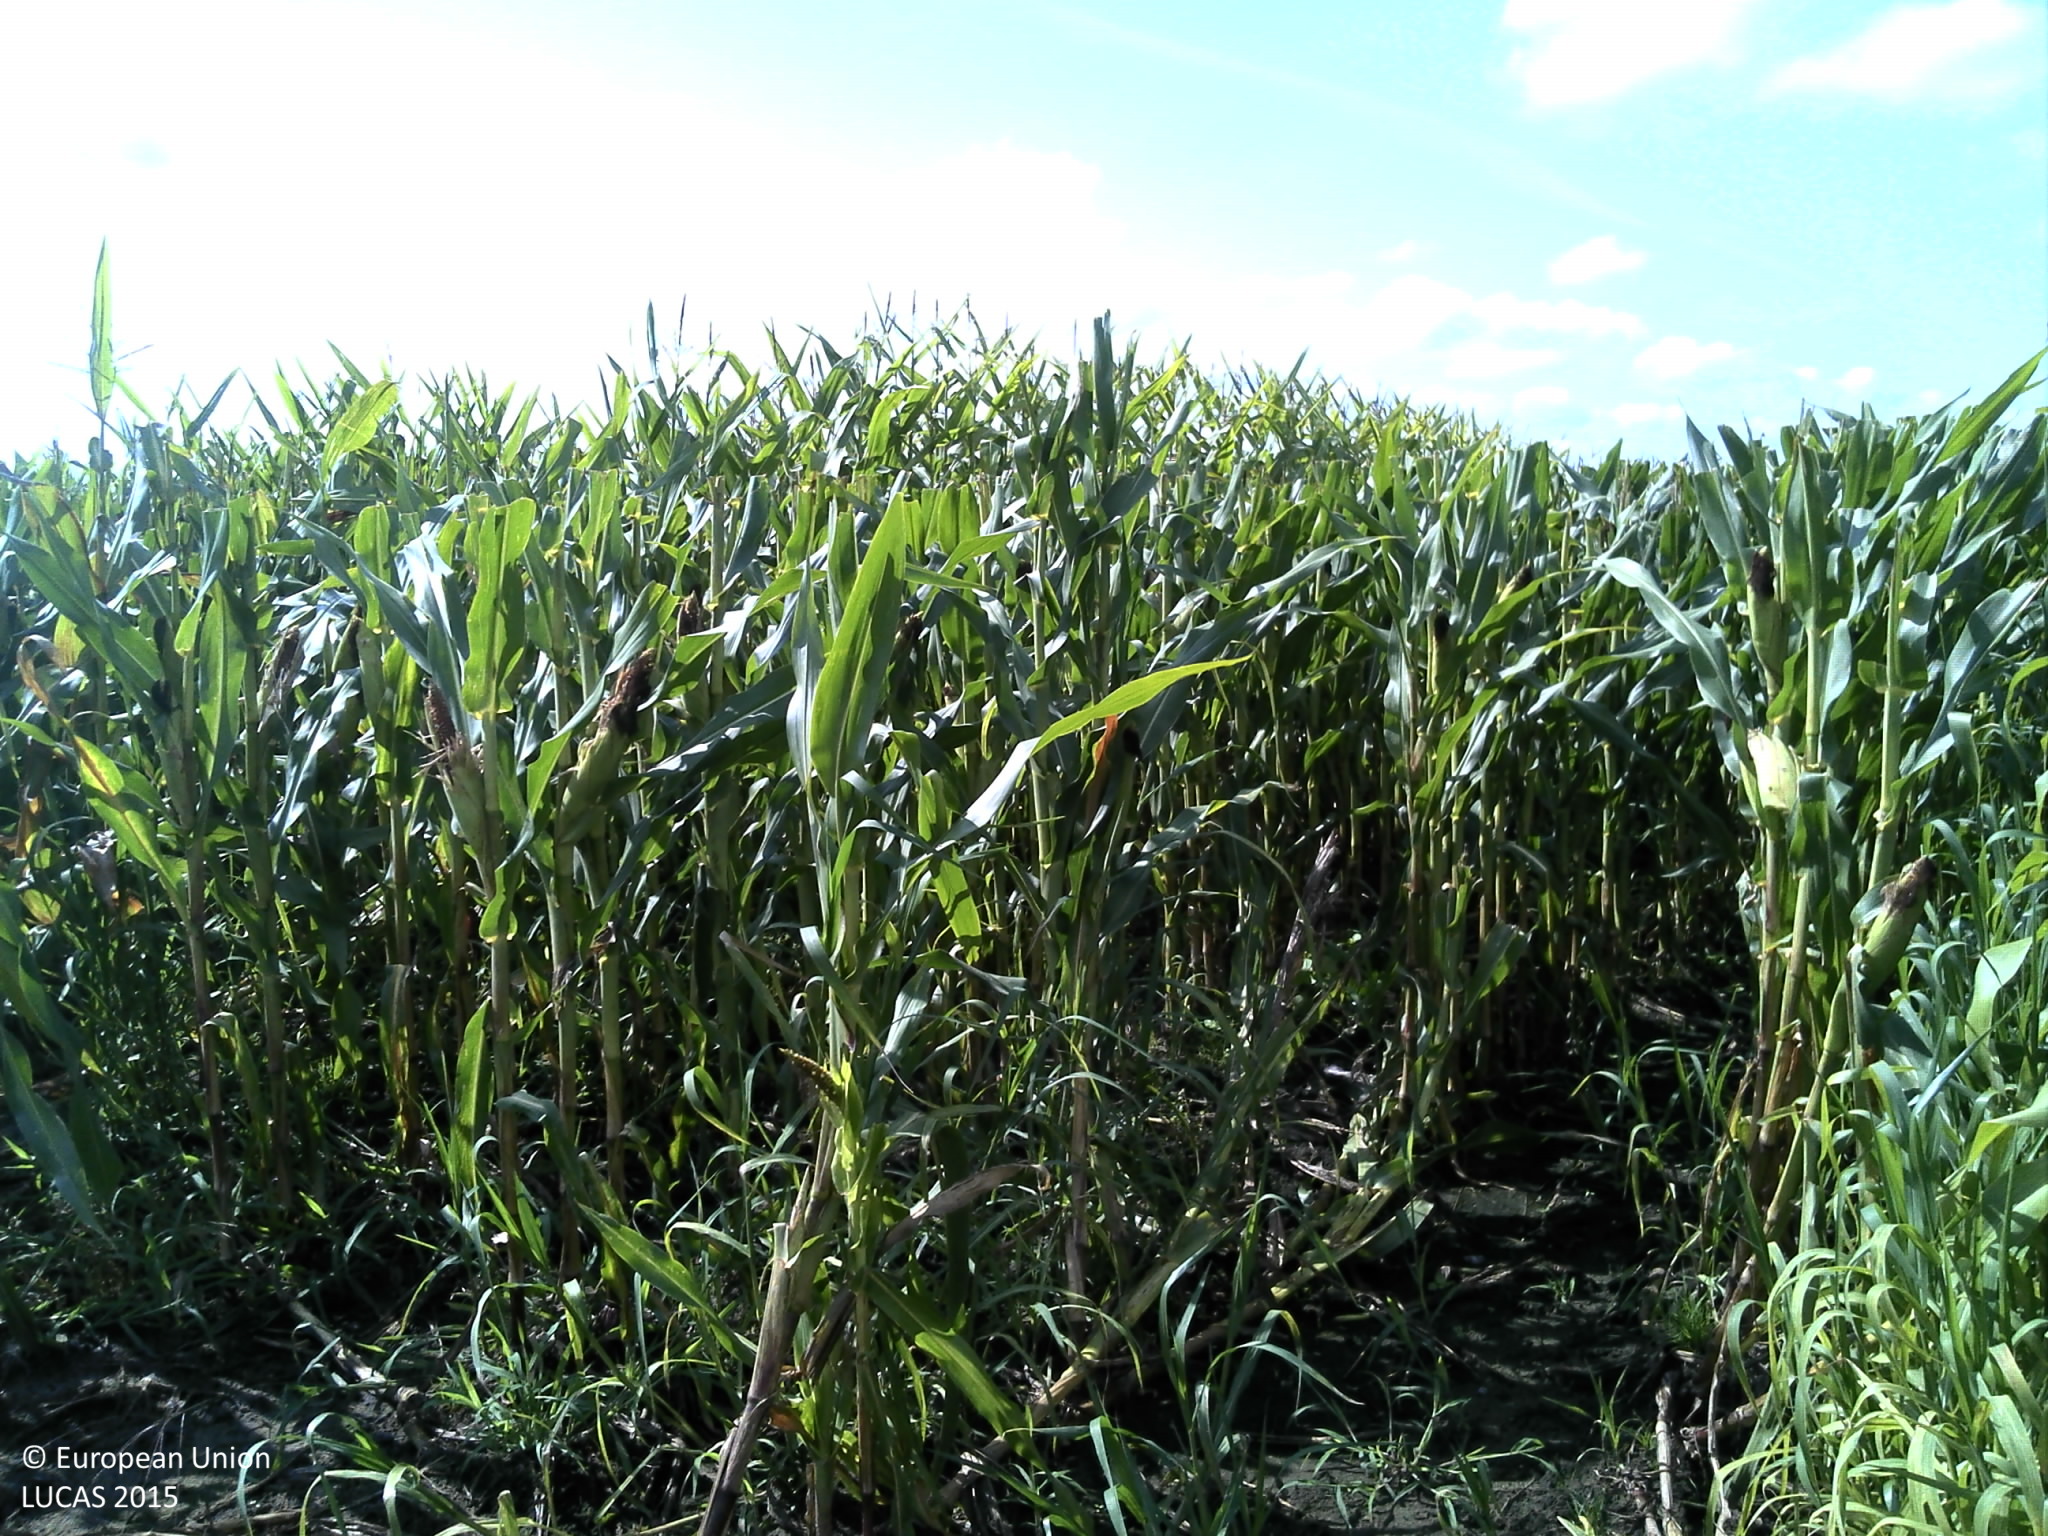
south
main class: Cropland
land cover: Maize
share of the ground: > 75 %
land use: Agriculture (excluding fallow land and kitchen gardens)
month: August
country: FR
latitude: 44.3752
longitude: -0.5451
